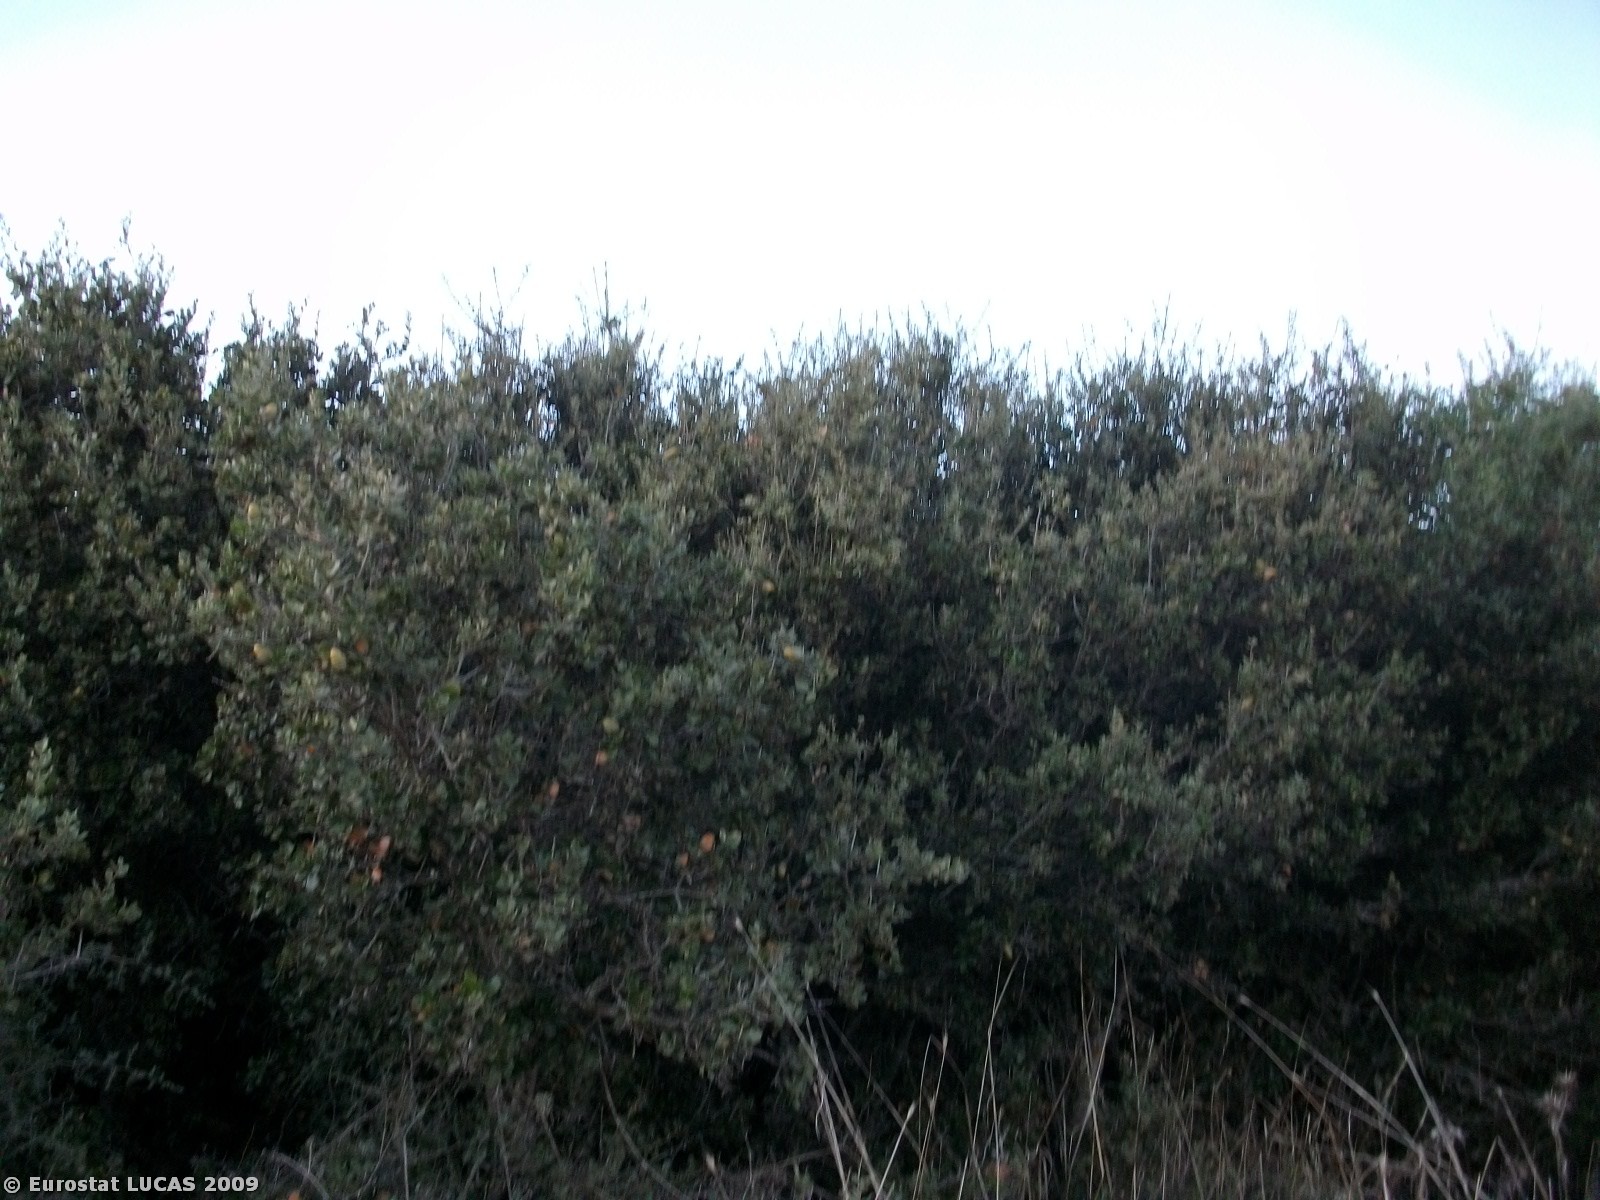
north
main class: Shrubland
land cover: Shrubland without tree cover
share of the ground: 25 - 50 %
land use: Unused
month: October
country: GR
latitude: 39.0944
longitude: 22.2490
